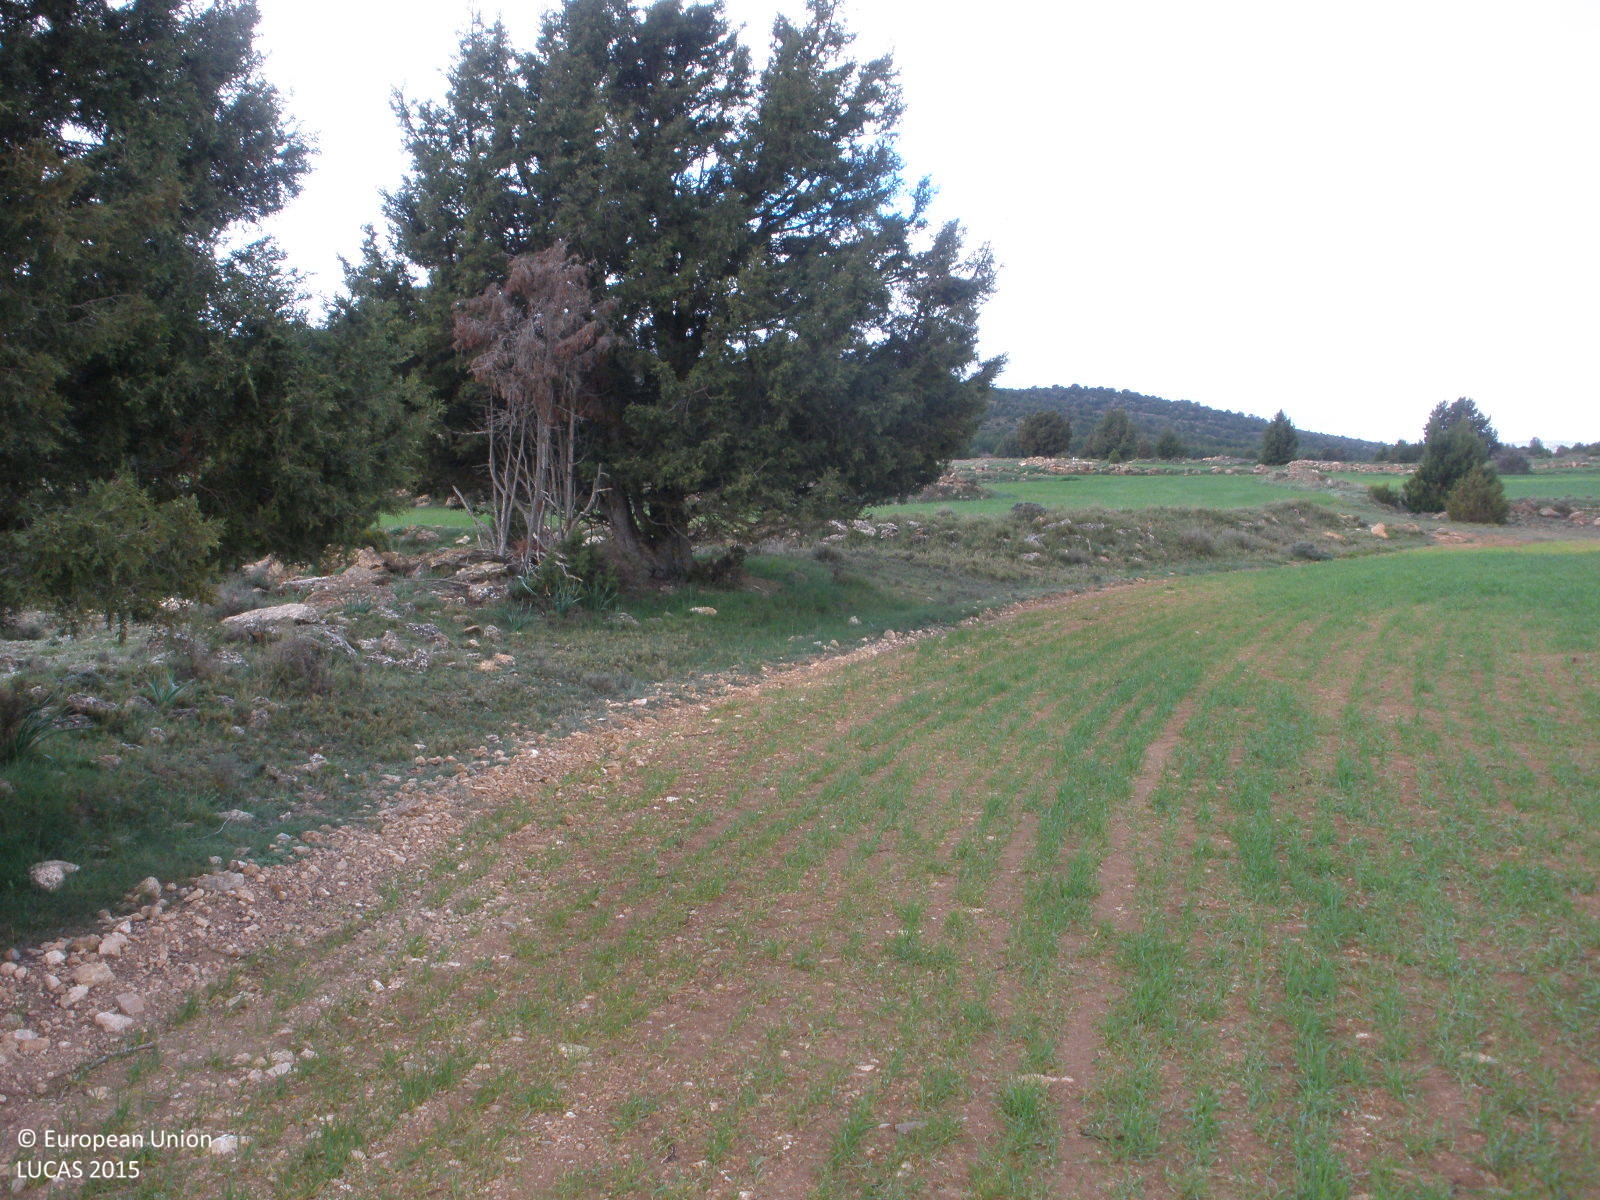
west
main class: Cropland
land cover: Barley
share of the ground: 50 - 75 %
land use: Agriculture (excluding fallow land and kitchen gardens)
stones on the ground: 25 - 50 %
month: April
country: ES
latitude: 40.3269
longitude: -1.2751
